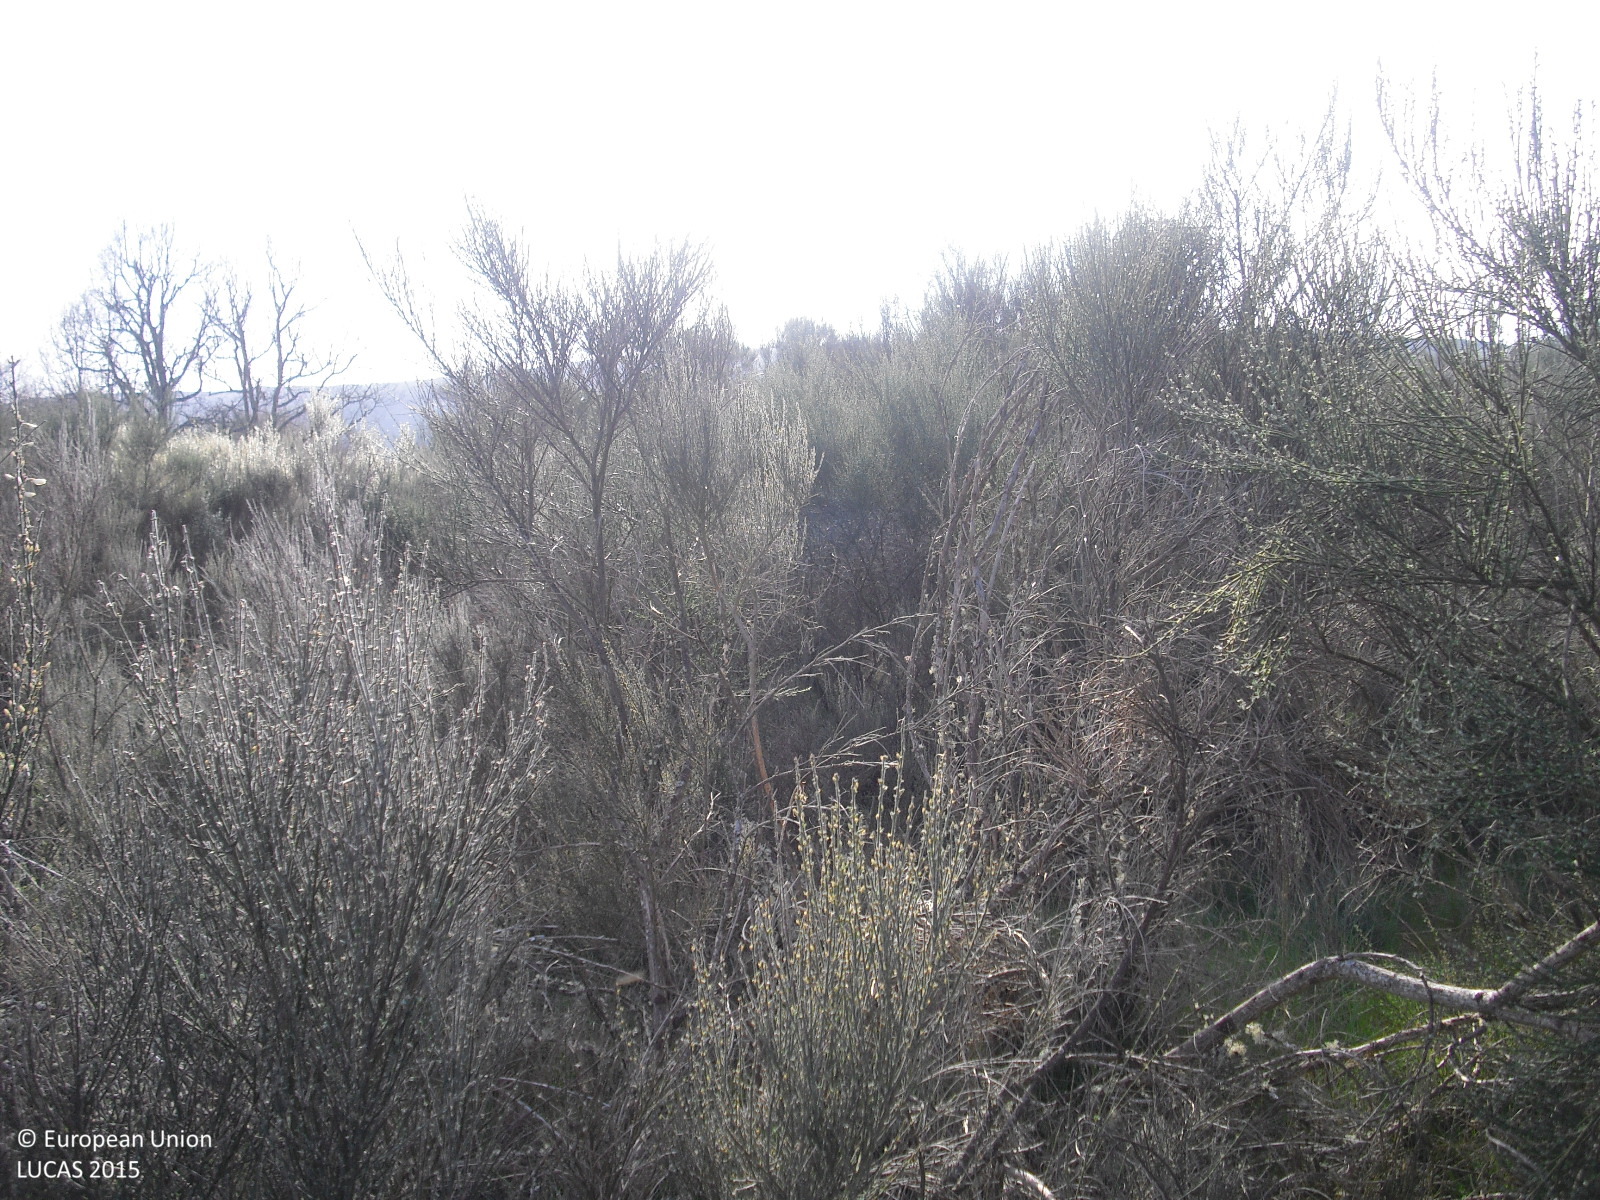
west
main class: Shrubland
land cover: Shrubland without tree cover
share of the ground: > 75 %
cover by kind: shrubs 70 %, herbaceous plants 30 %
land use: Abandoned areas
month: April
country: ES
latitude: 41.9224
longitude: -7.6337
